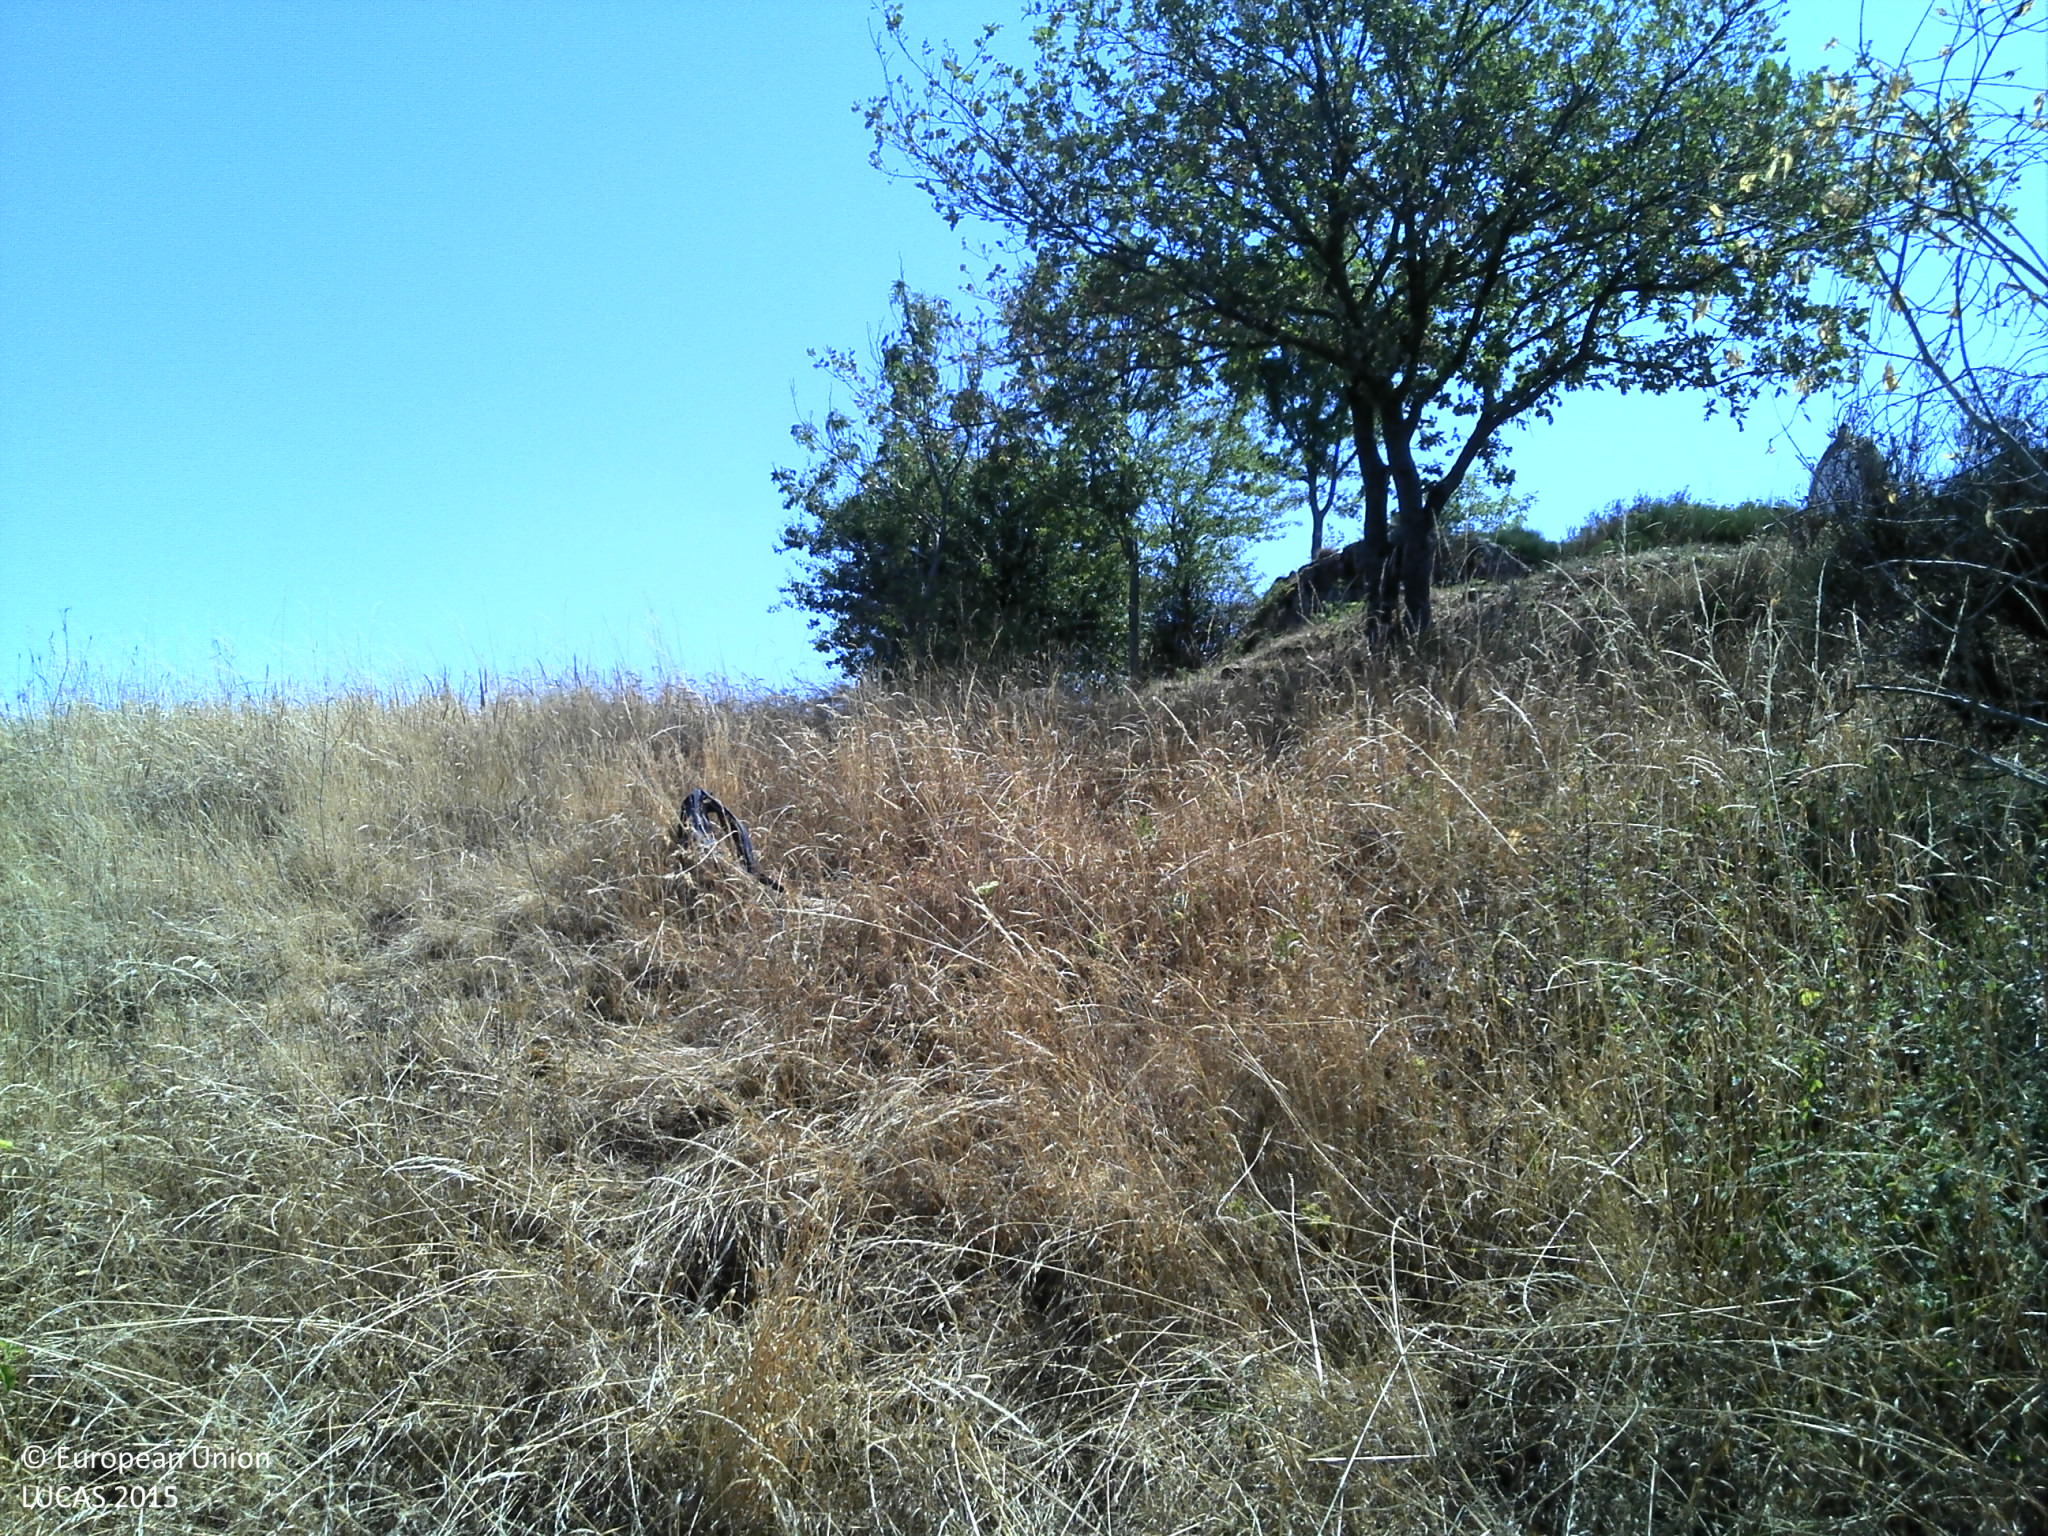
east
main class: Woodland
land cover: Broadleaved woodland
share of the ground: > 75 %
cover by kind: herbaceous plants 50 %, broadleaved forest trees 30 %, shrubs 20 %
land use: Semi-natural and natural areas not in use
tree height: < 5 m
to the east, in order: Broadleaved woodland; Tracks; Grassland with sparse tree/shrub cover; Tracks; Grass margins; Fences; Abandoned hedges; Rocks and stones; Railways; Rocks and stones; Abandoned hedges; Fences; Grassland without tree/shrub cover
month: July
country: FR
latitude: 45.9869
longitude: 4.0505
